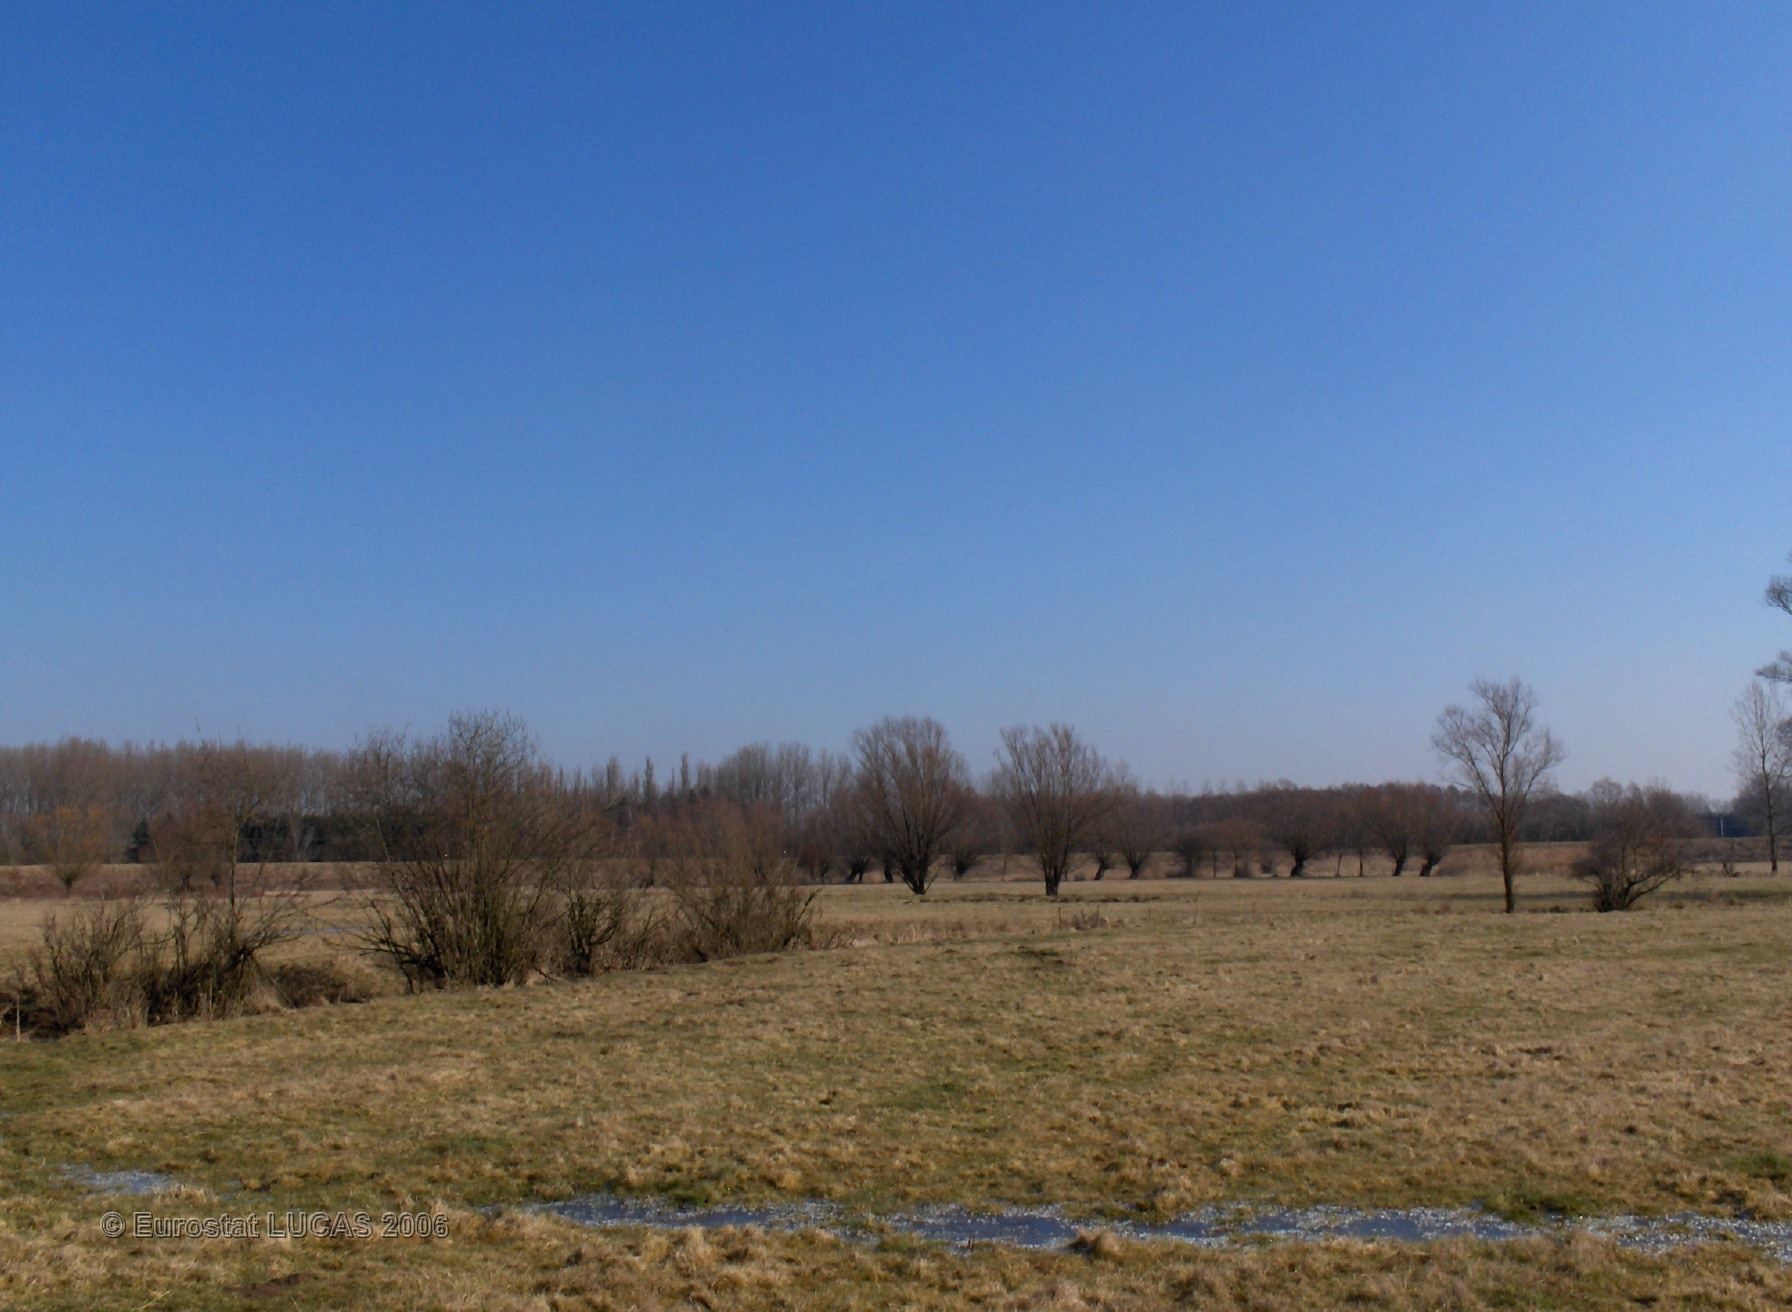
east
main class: Grassland
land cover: Grassland with sparse tree/shrub cover
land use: Agriculture (excluding fallow land and kitchen gardens)
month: March
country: BE
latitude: 50.9646
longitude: 5.1705
